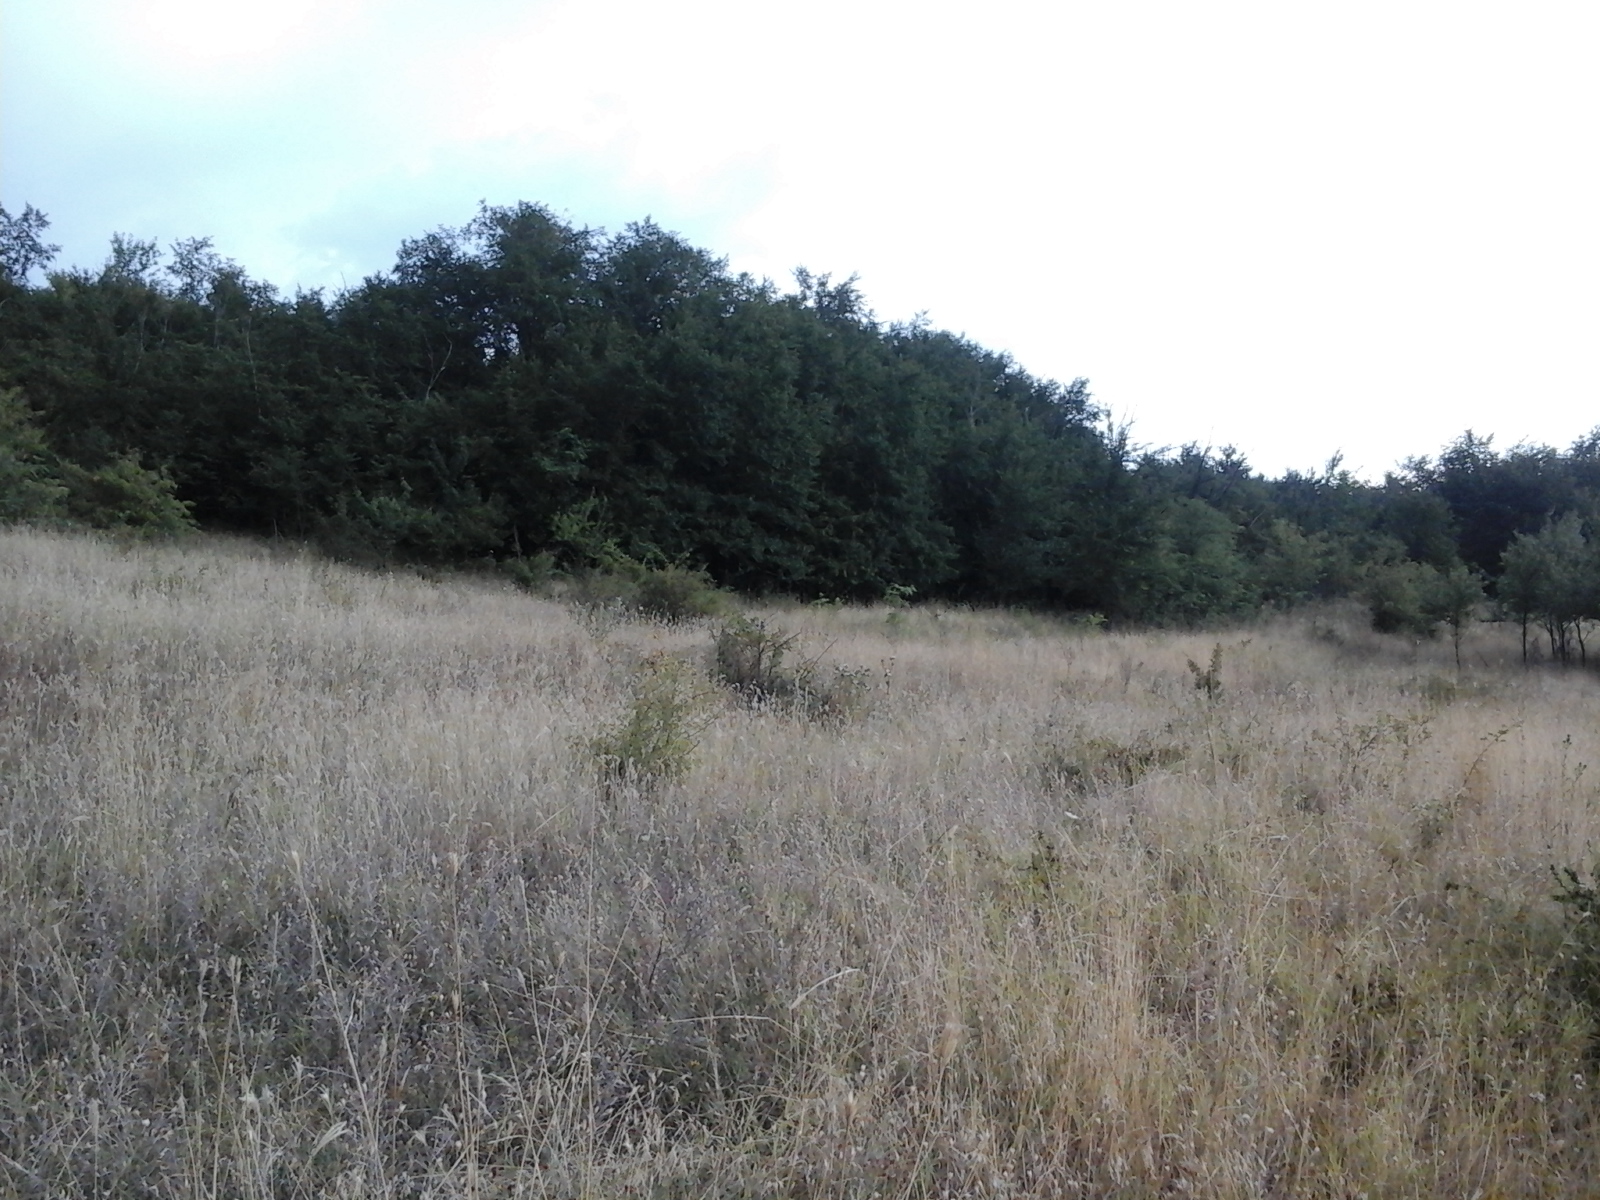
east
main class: Grassland
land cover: Grassland with sparse tree/shrub cover
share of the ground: > 75 %
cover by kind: herbaceous plants 90 %, broadleaved forest trees 5 %, shrubs 5 %
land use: Agriculture (excluding fallow land and kitchen gardens)
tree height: < 5 m
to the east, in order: Grassland with sparse tree/shrub cover; Broadleaved woodland; Shrubland with sparse tree cover
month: August
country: RO
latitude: 44.3181
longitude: 23.2504
